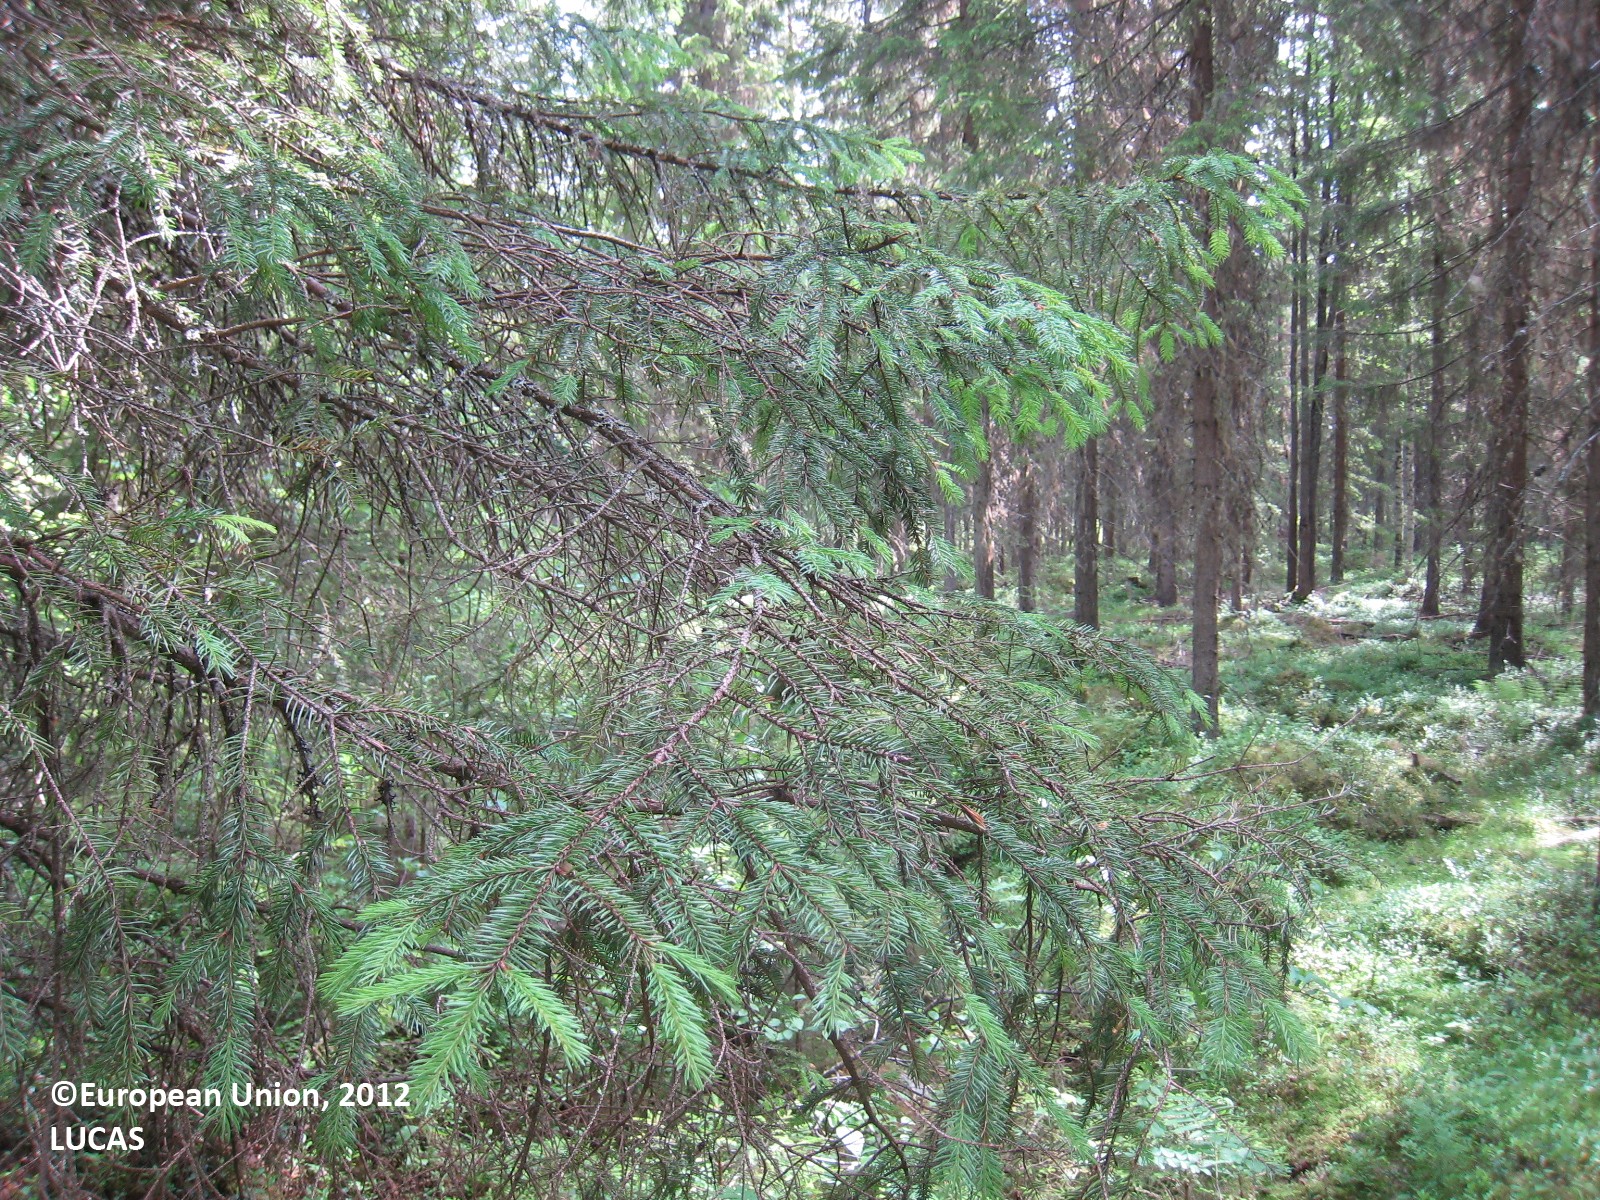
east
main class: Woodland
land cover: Spruce dominated coniferous woodland
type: boreal forest
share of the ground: 50 - 75 %
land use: Forestry
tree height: > 5 m
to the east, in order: Spruce dominated coniferous woodland; Ditches and canals; Spruce dominated coniferous woodland; Ditches and canals; Spruce dominated coniferous woodland; Ditches and canals; Spruce dominated coniferous woodland; Ditches and canals; Spruce dominated mixed woodland; Ditches and canals; Spruce dominated mixed woodland; Ditches and canals; Spruce dominated mixed woodland
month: July
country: FI
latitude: 63.1970
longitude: 25.7545
